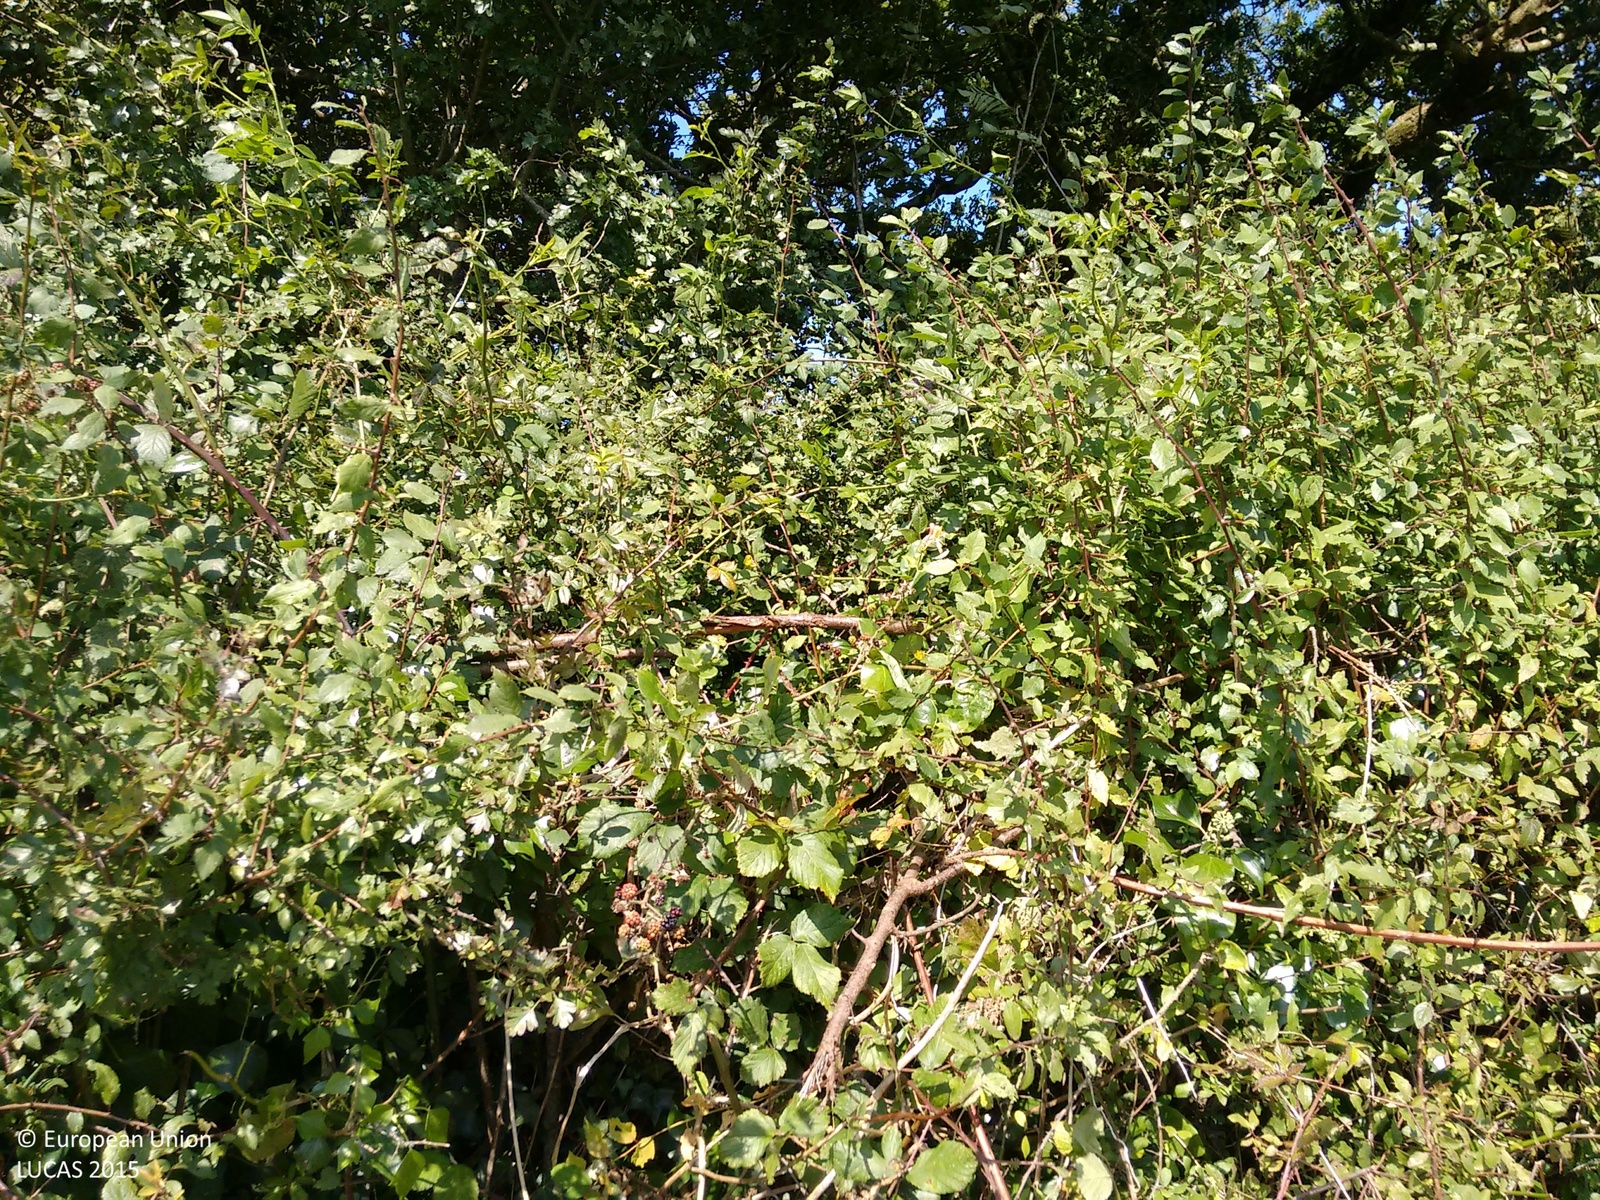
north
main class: Woodland
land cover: Broadleaved woodland
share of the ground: > 75 %
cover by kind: broadleaved forest trees 100 %
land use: Agriculture (excluding fallow land and kitchen gardens)
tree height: > 5 m
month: September
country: GB
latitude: 50.8593
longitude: -4.0605
